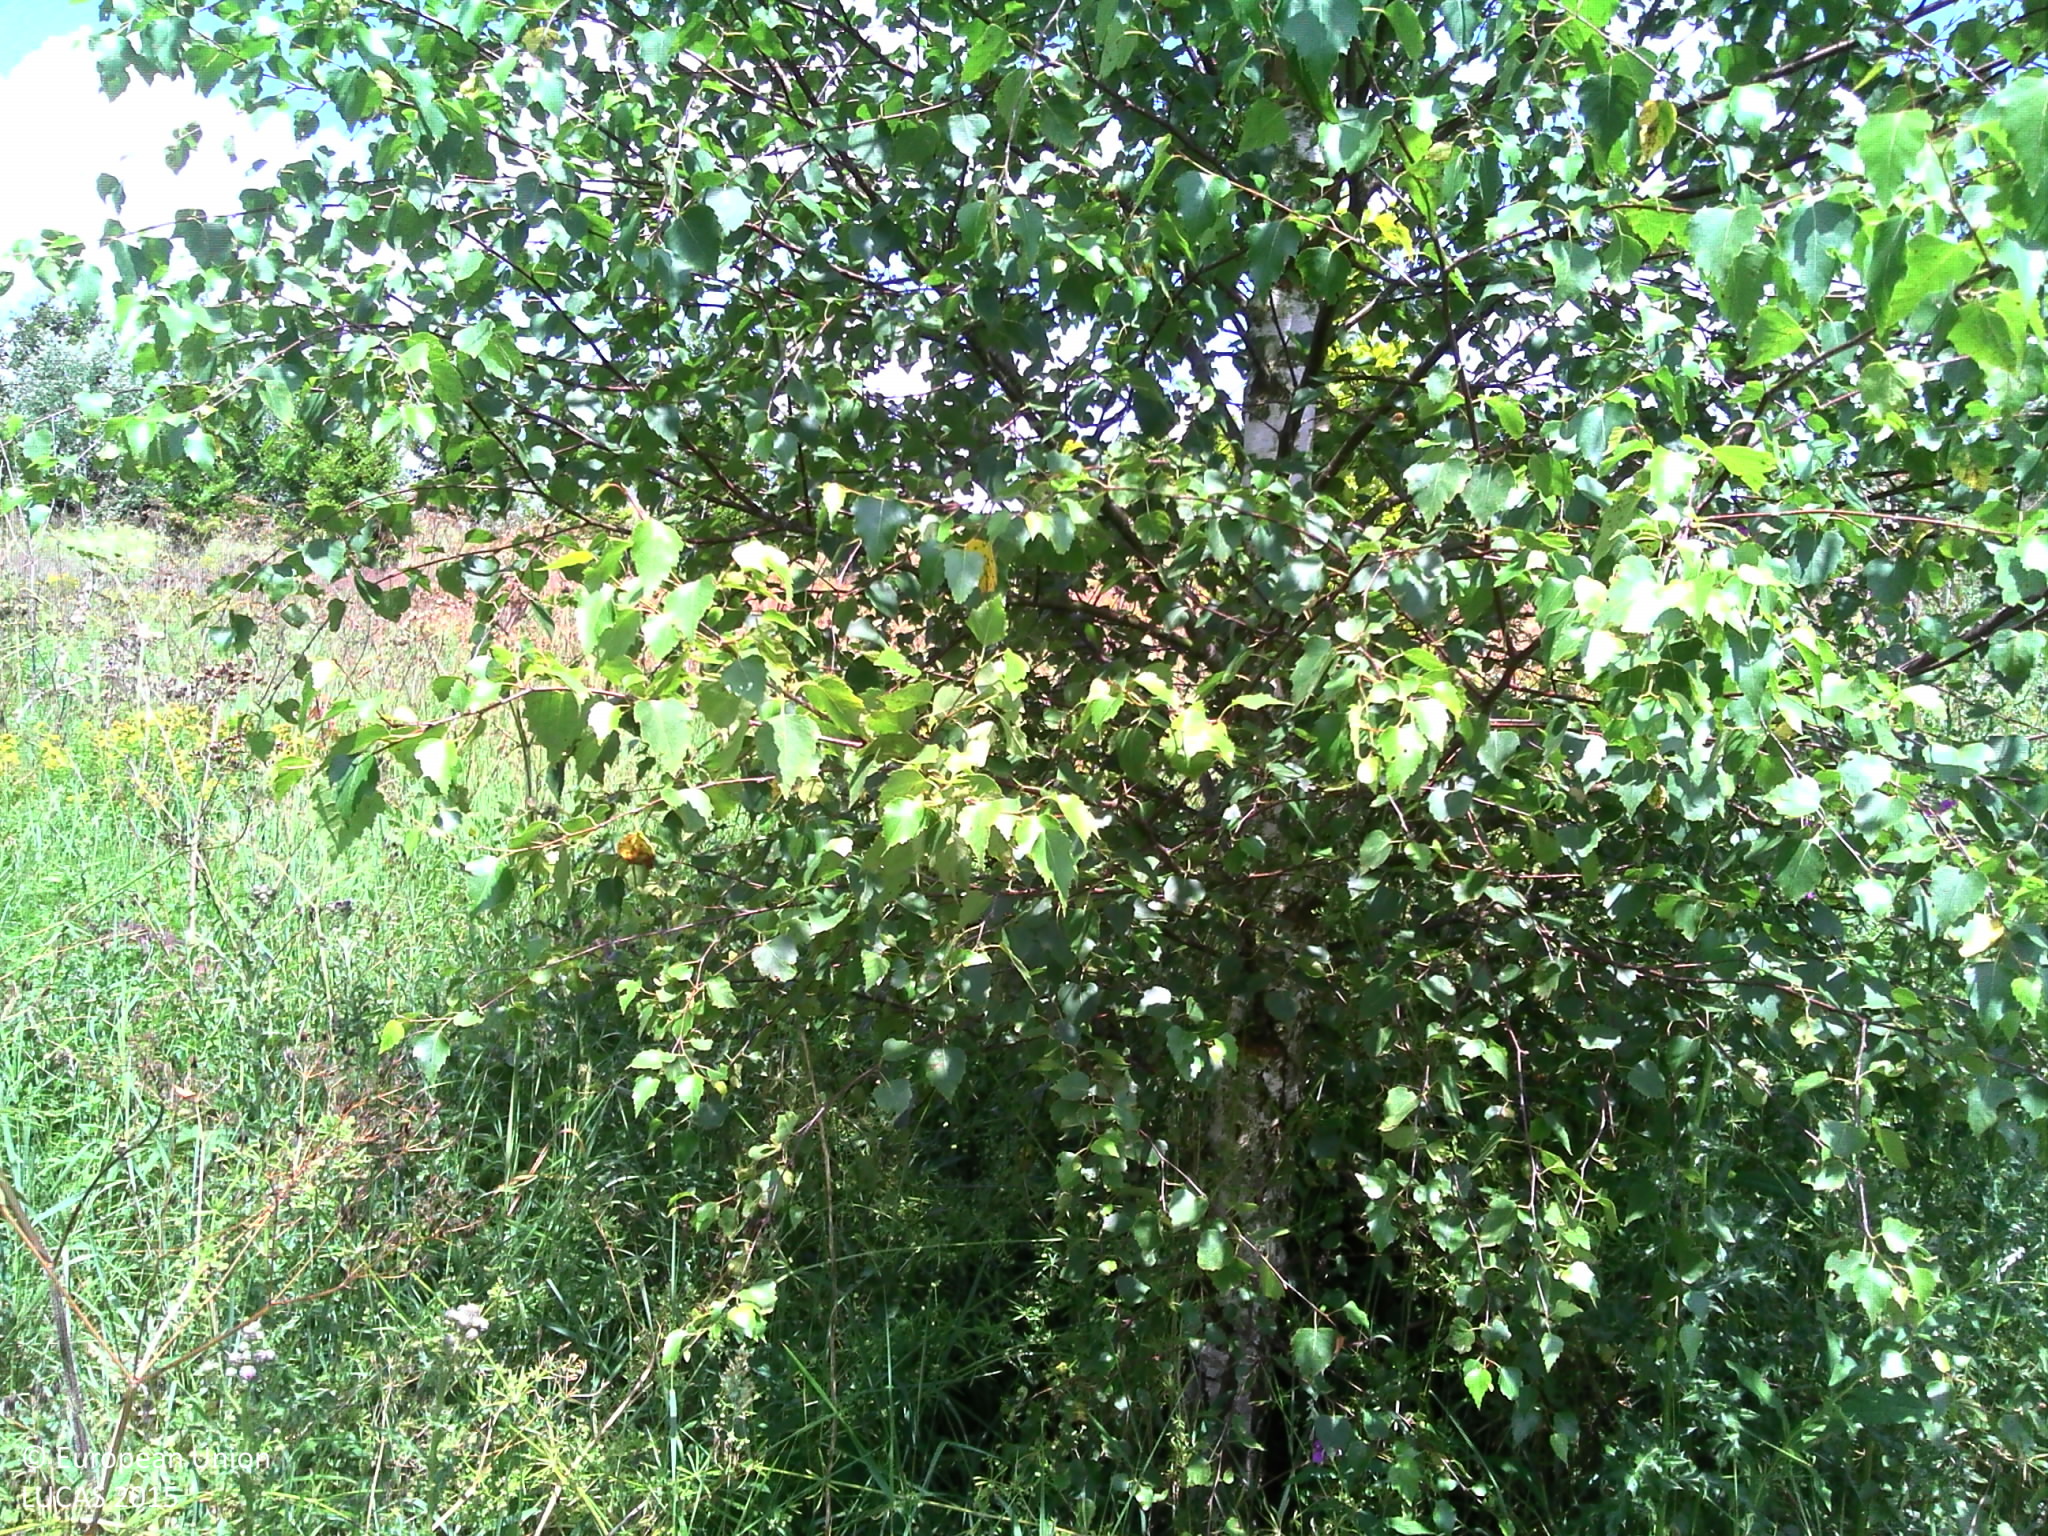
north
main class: Woodland
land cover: Broadleaved woodland
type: exotic forest
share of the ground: 10 - 25 %
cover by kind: herbaceous plants 75 %, broadleaved forest trees 20 %, shrubs 5 %
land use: Forestry
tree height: < 5 m
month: July
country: BE
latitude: 49.9989
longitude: 5.7996
